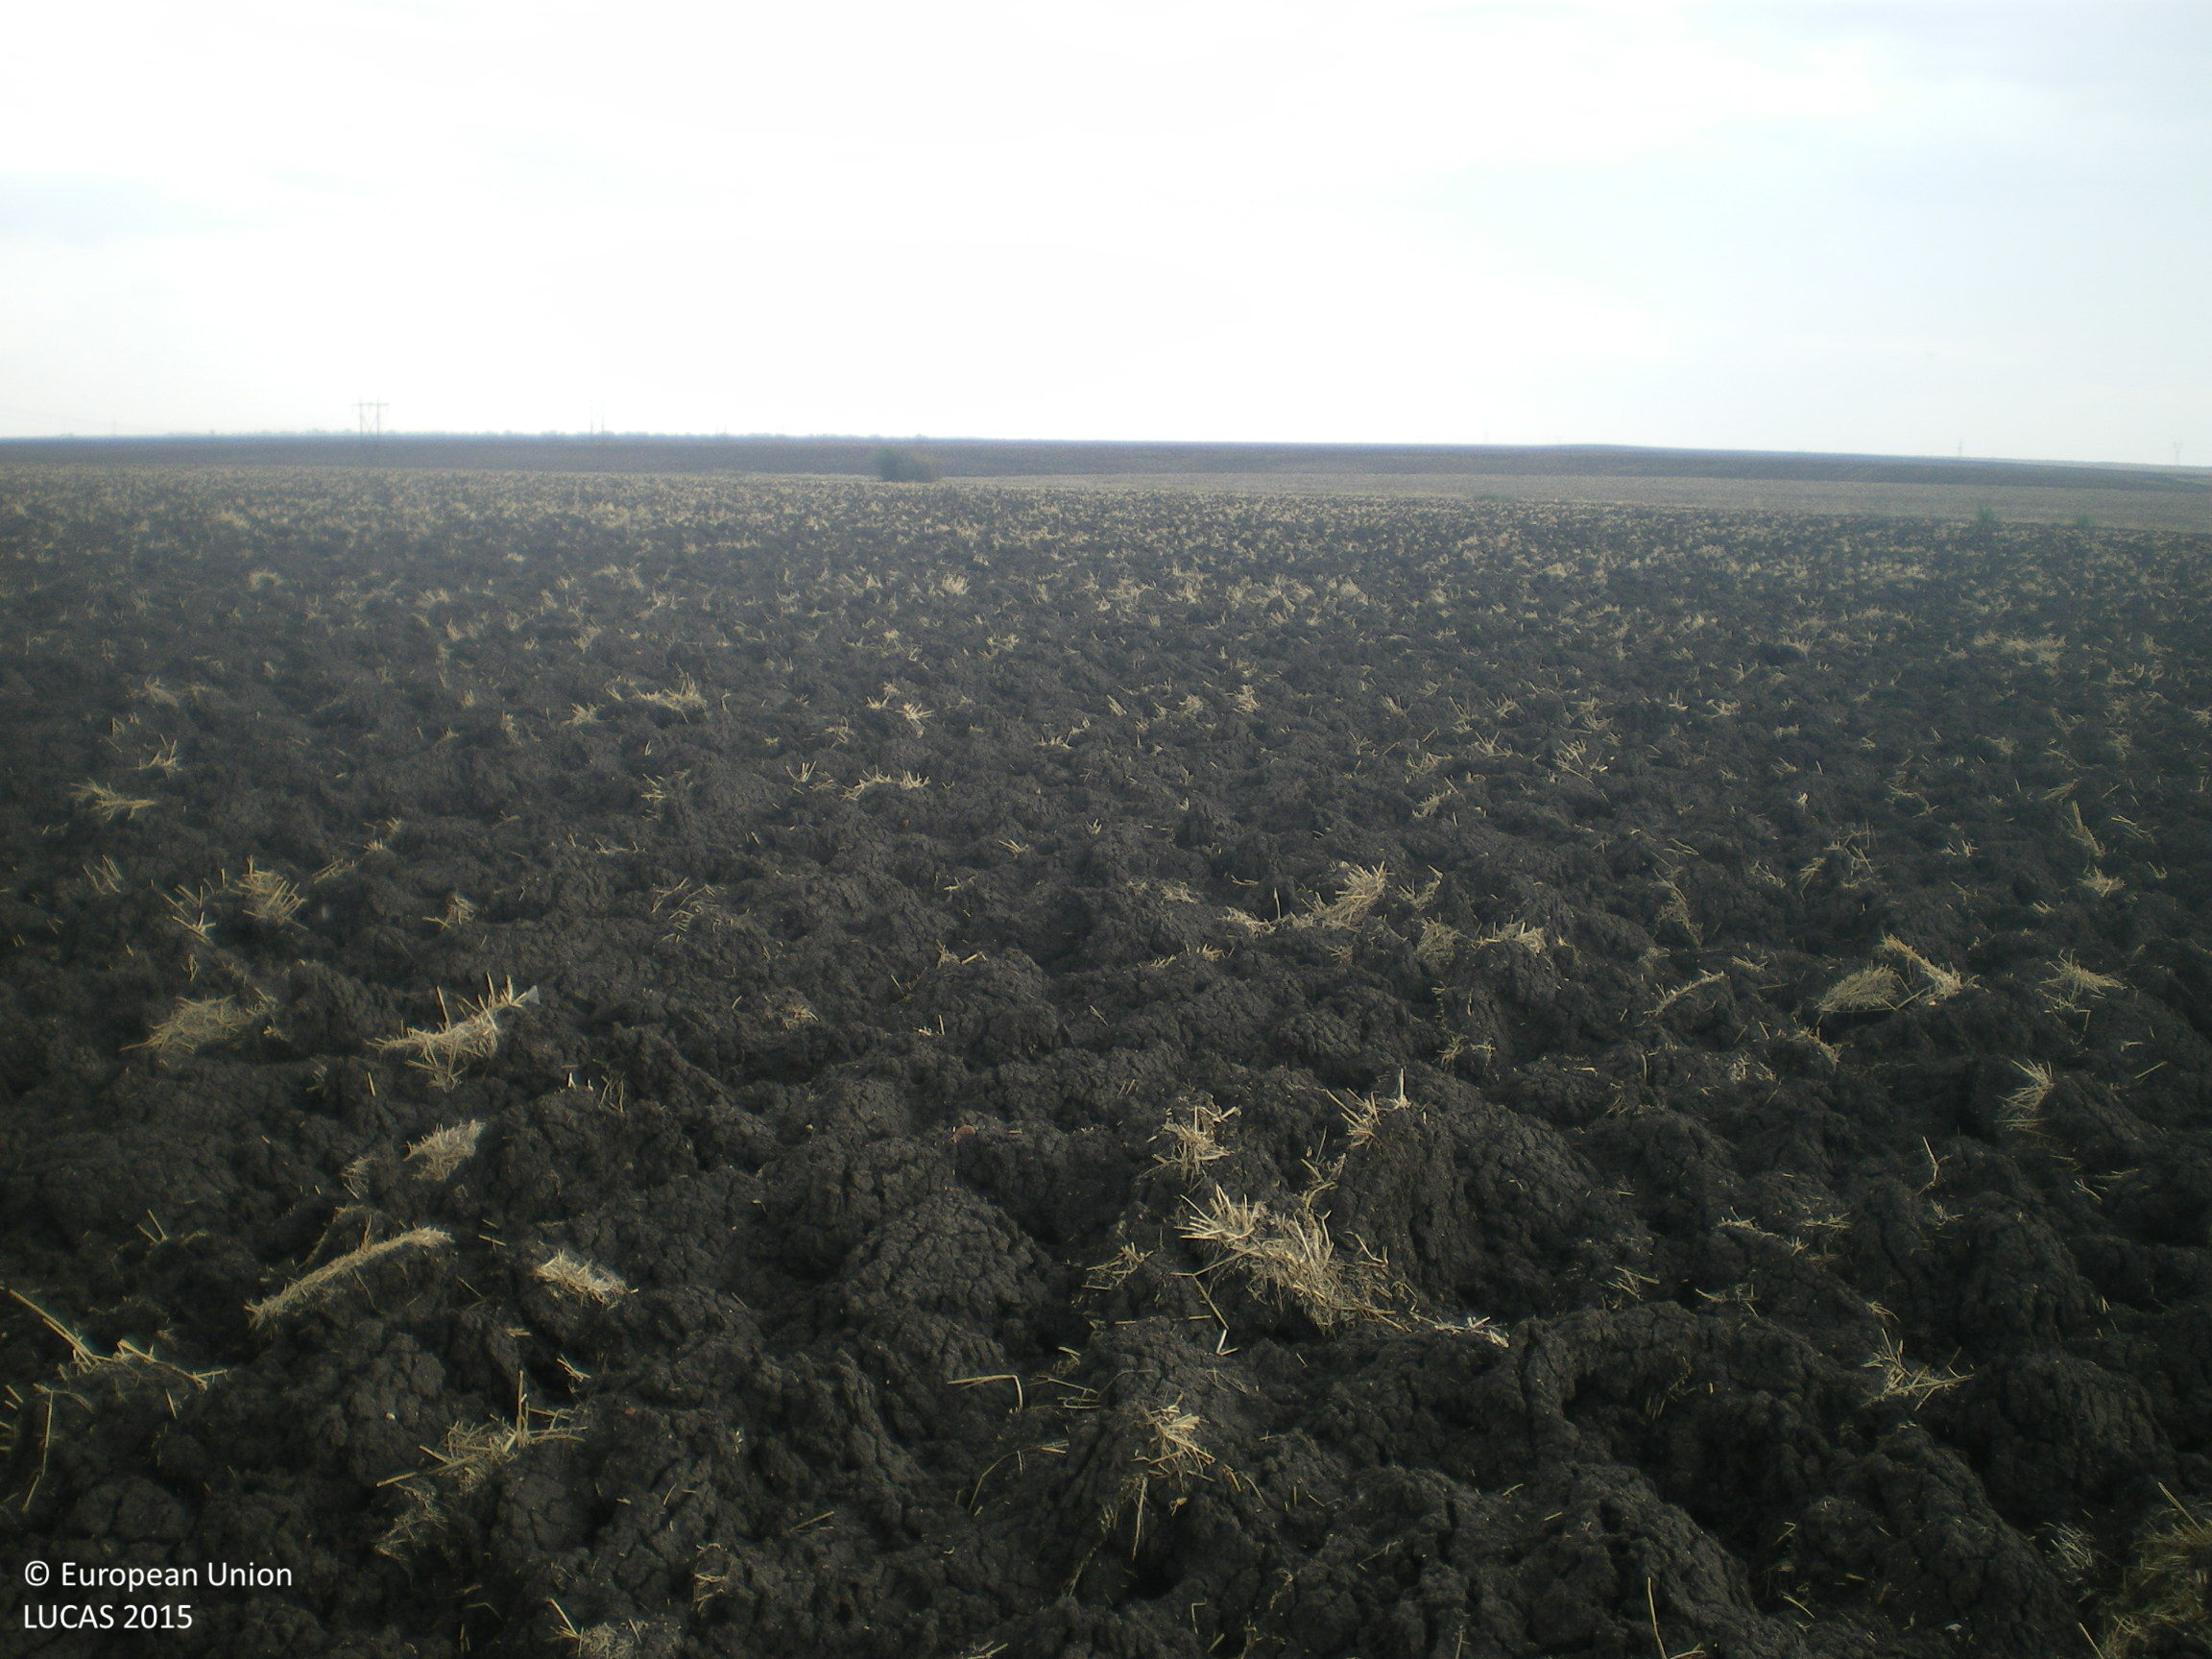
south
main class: Cropland
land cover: Oats
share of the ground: < 10 %
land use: Agriculture (excluding fallow land and kitchen gardens)
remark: Harvested field
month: August
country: BG
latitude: 42.2607
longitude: 25.8457
